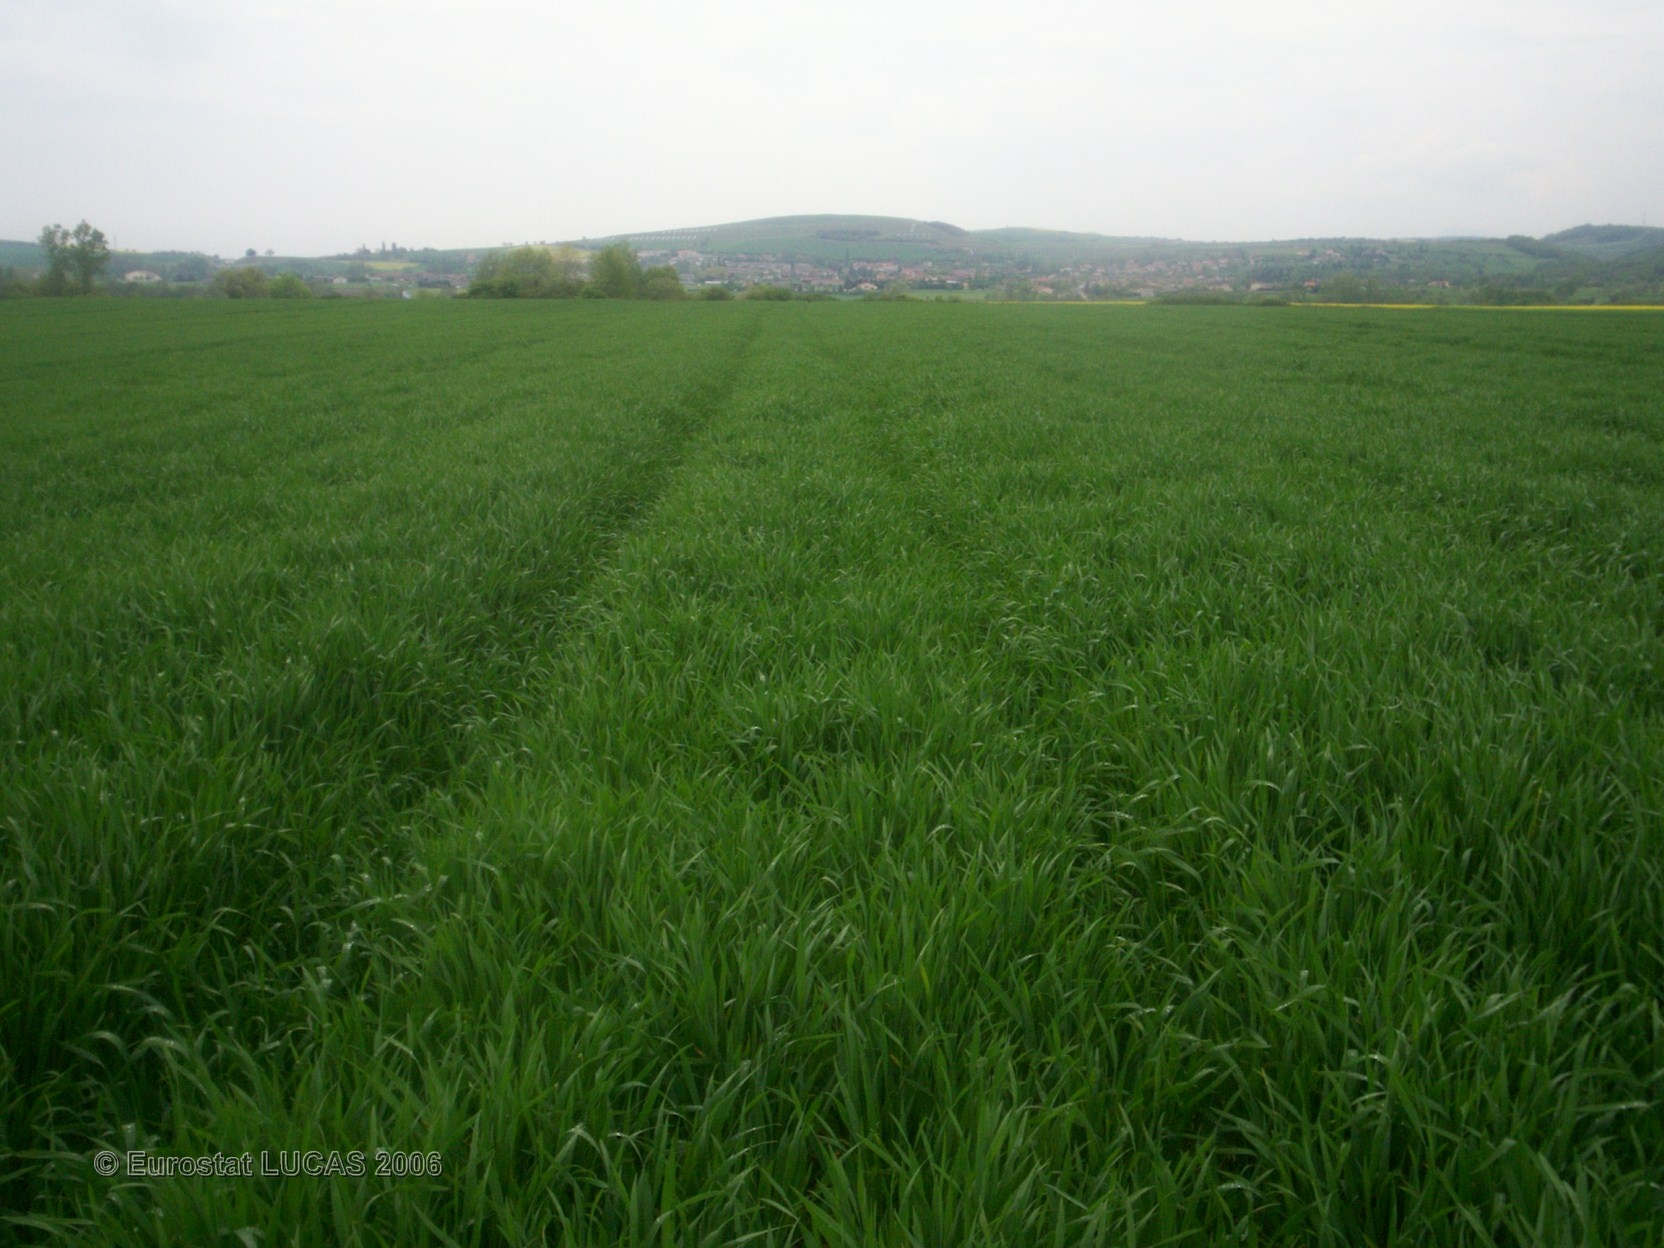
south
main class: Cropland
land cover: Common wheat
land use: Agriculture (excluding fallow land and kitchen gardens)
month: May
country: FR
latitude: 46.0012
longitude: 3.0907
